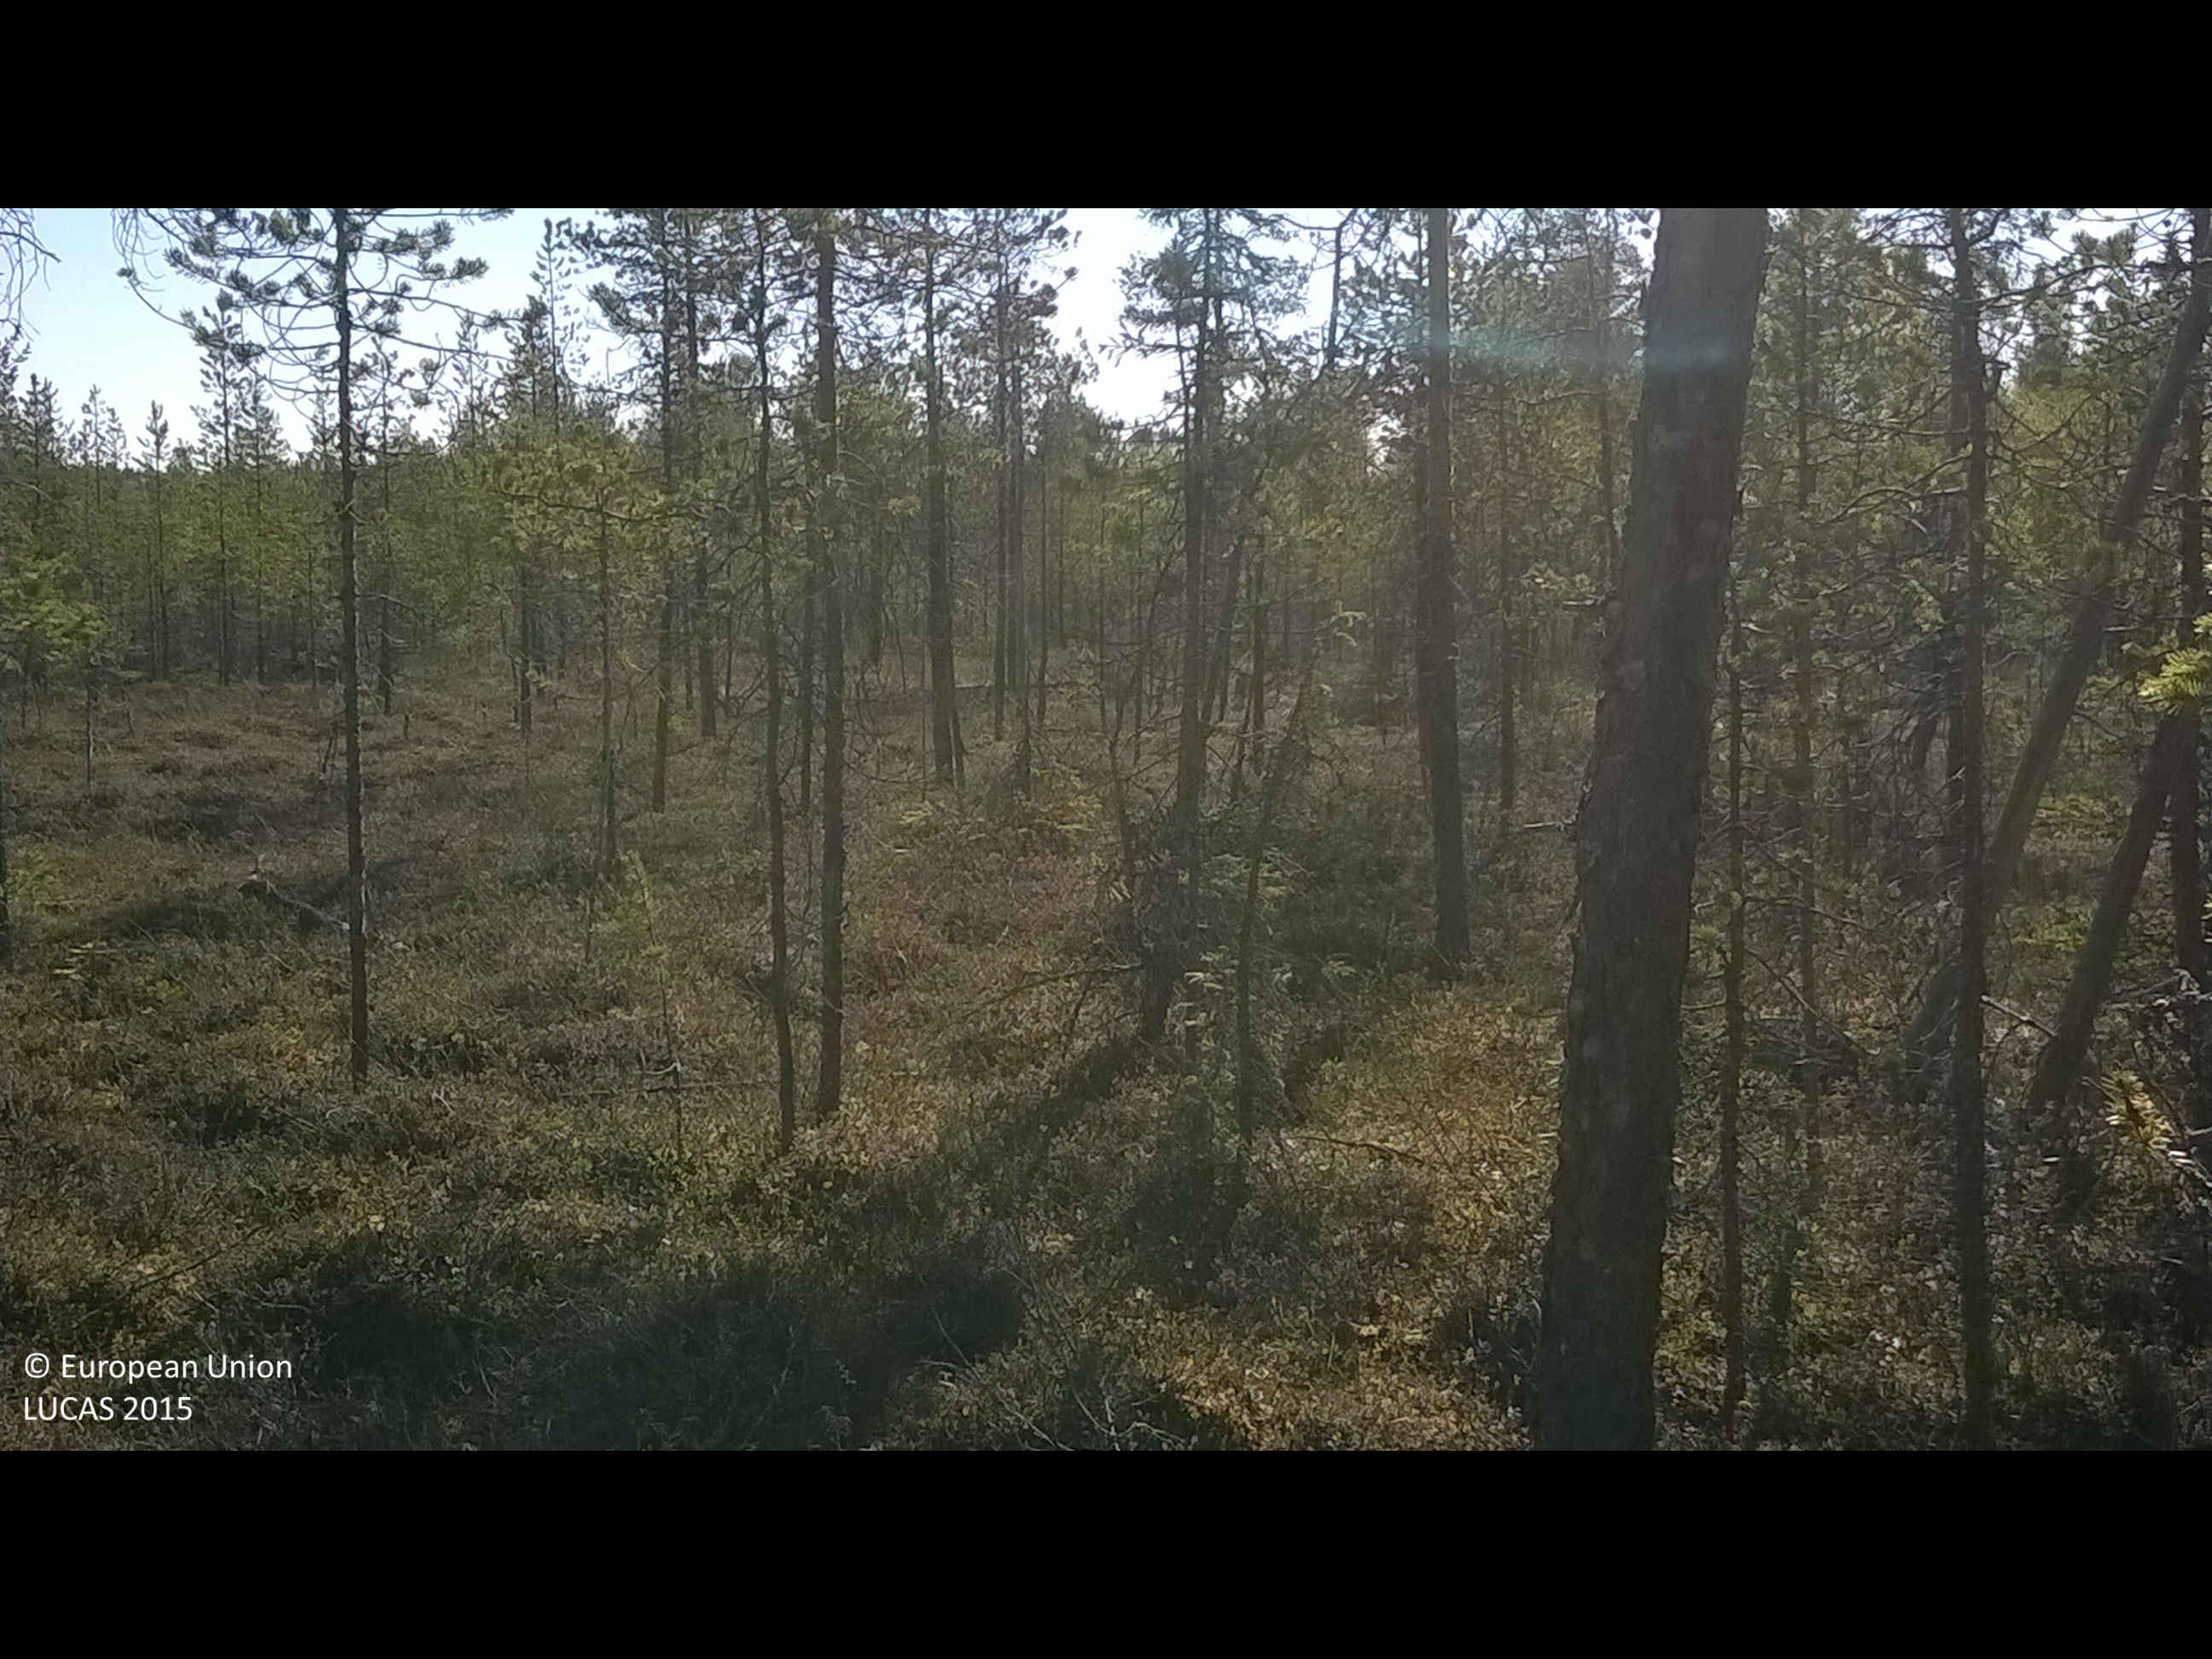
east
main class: Woodland
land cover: Pine dominated coniferous woodland
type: mire and swamp forests
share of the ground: 50 - 75 %
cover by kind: coniferous forest trees 50 %, shrubs 25 %, lichens and mosses 25 %
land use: Forestry
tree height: > 5 m
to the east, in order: Pine dominated coniferous woodland; Tracks; Pine dominated coniferous woodland; Pine dominated mixed woodland; Other mixed woodland; Inland fresh water bodies
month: June
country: FI
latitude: 66.6395
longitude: 26.5622
